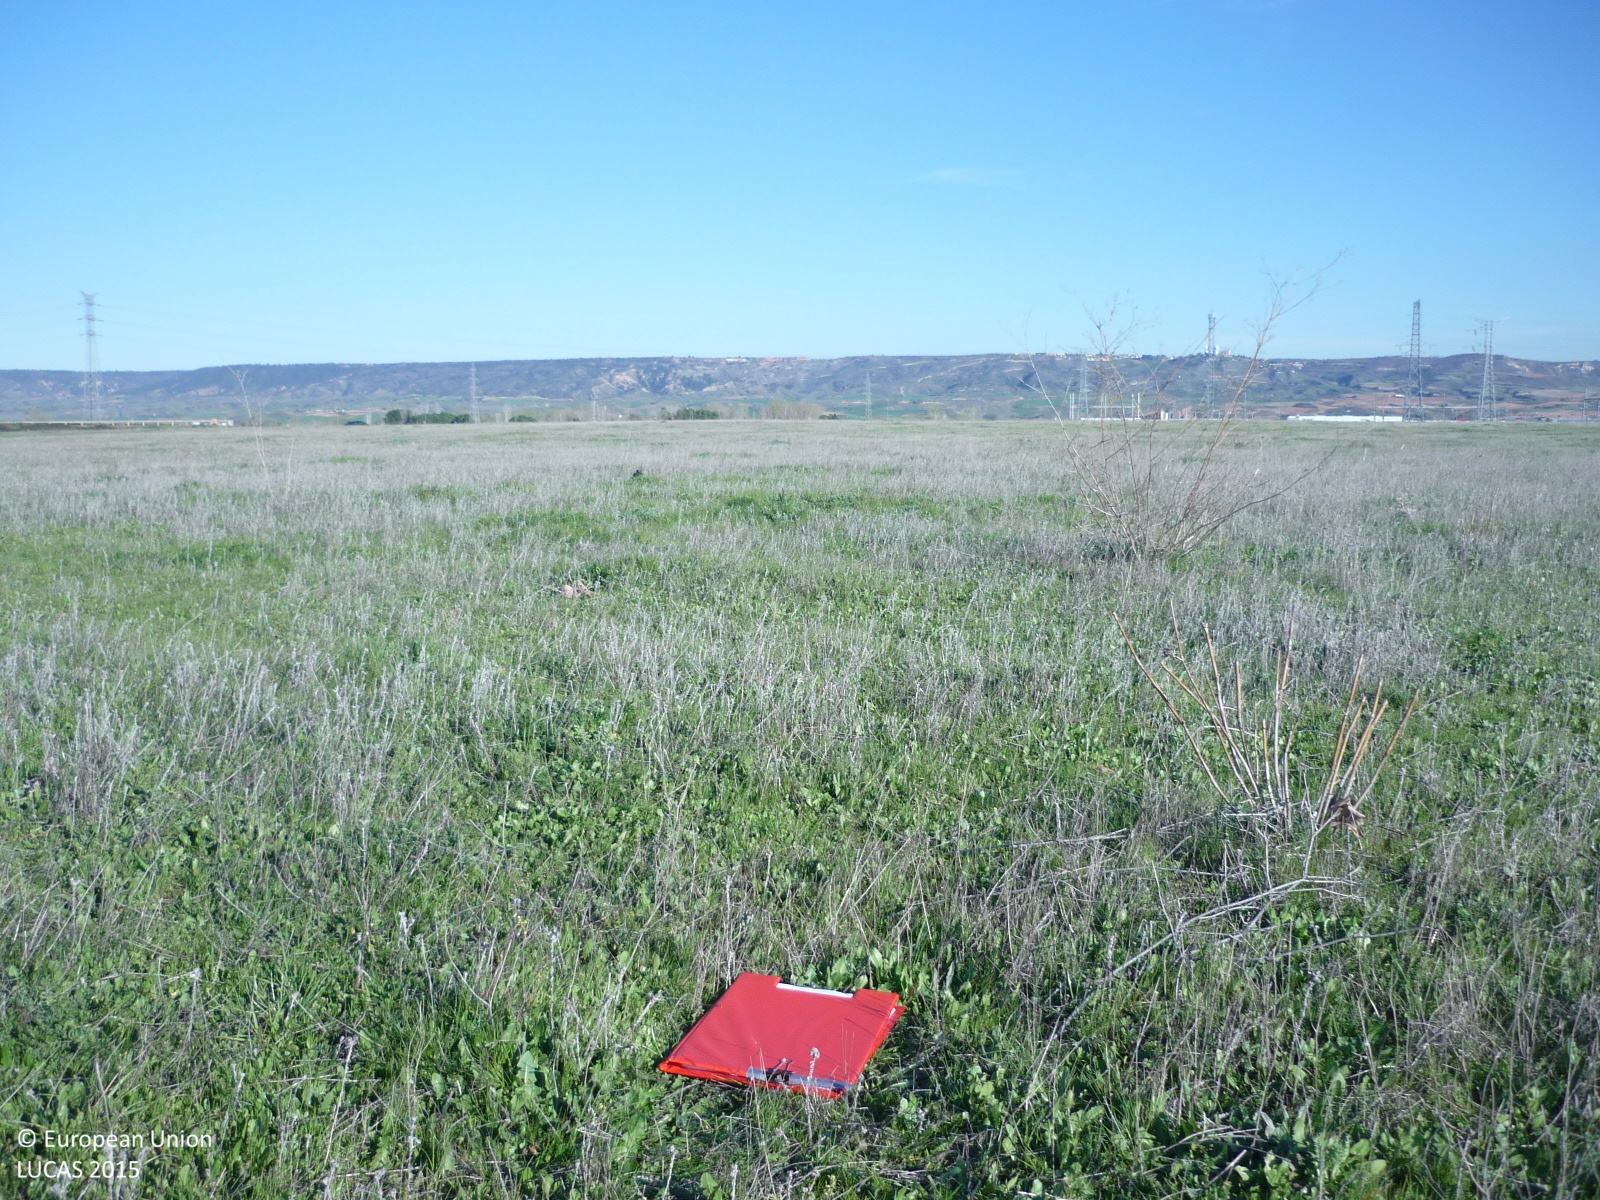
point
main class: Grassland
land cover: Grassland without tree/shrub cover
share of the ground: > 75 %
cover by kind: herbaceous plants 100 %
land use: Semi-natural and natural areas not in use
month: March
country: ES
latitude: 40.5448
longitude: -3.3178
